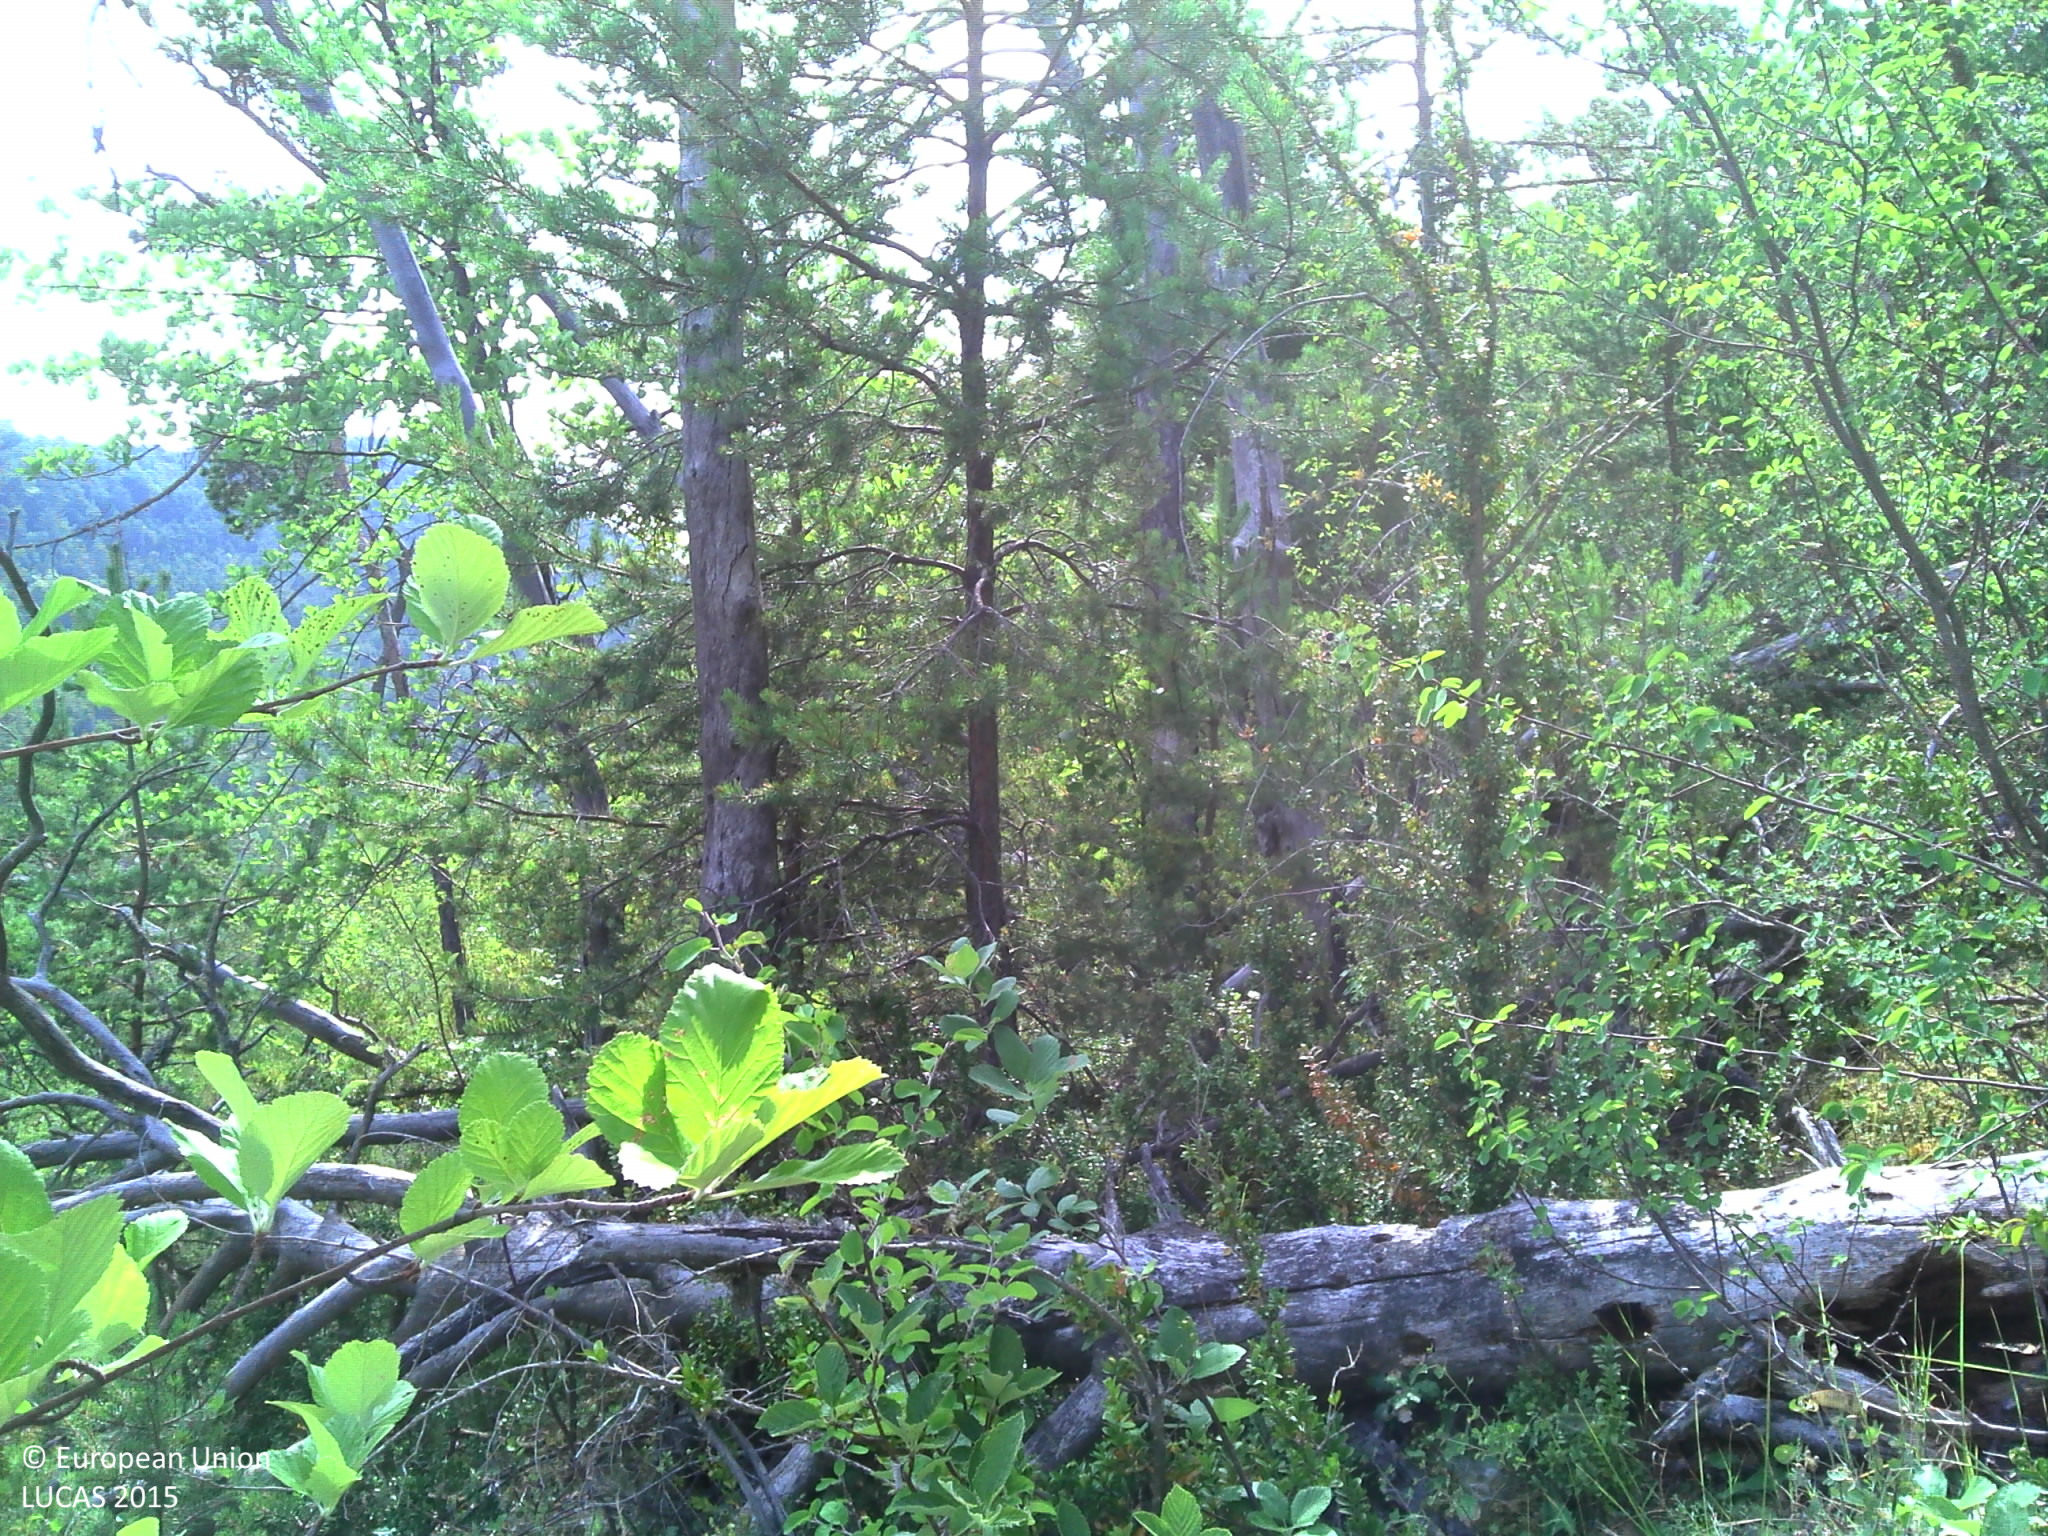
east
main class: Woodland
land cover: Pine dominated mixed woodland
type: coniferous forest of the mediterranean region
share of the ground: 50 - 75 %
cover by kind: coniferous forest trees 40 %, broadleaved forest trees 20 %, herbaceous plants 20 %, shrubs 10 %, lichens and mosses 10 %
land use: Forestry
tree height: > 5 m
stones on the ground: 25 - 50 %
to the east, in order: Pine dominated mixed woodland; Grass margins; Tracks; Pine dominated mixed woodland
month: July
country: FR
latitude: 43.7977
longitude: 6.3168
